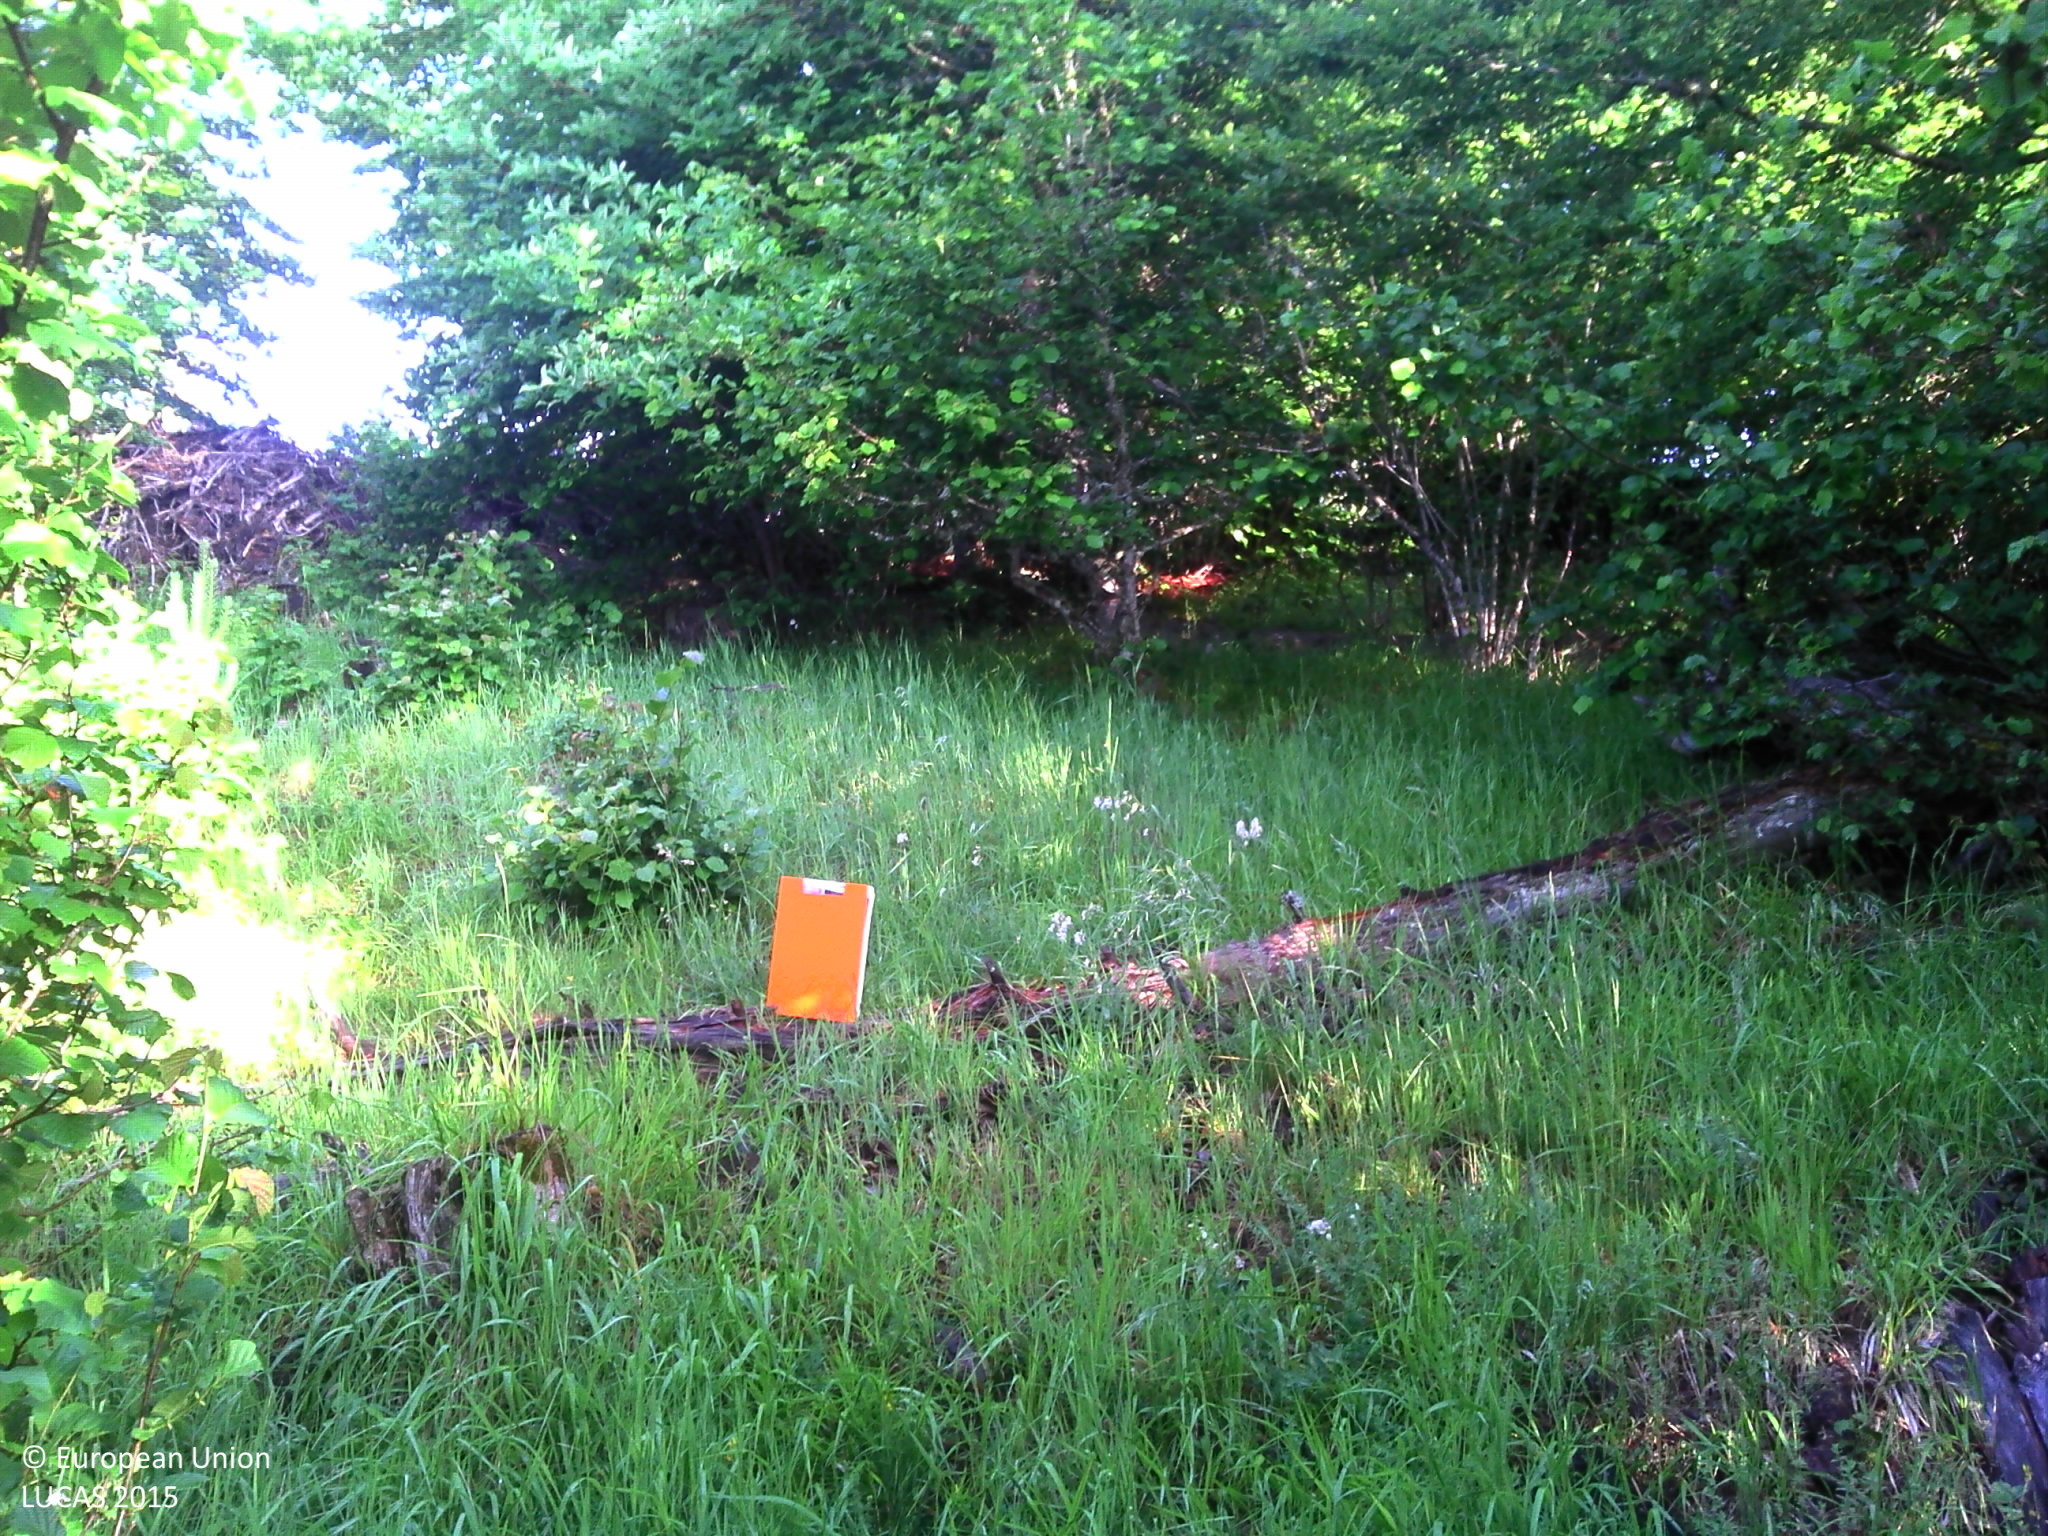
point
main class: Woodland
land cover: Pine dominated mixed woodland
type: alpine coniferous forest
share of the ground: > 75 %
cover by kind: broadleaved forest trees 50 %, coniferous forest trees 20 %, herbaceous plants 20 %, shrubs 10 %
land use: Forestry
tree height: > 5 m
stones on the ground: 10 - 25 %
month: June
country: FR
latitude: 45.1757
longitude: 2.9135
